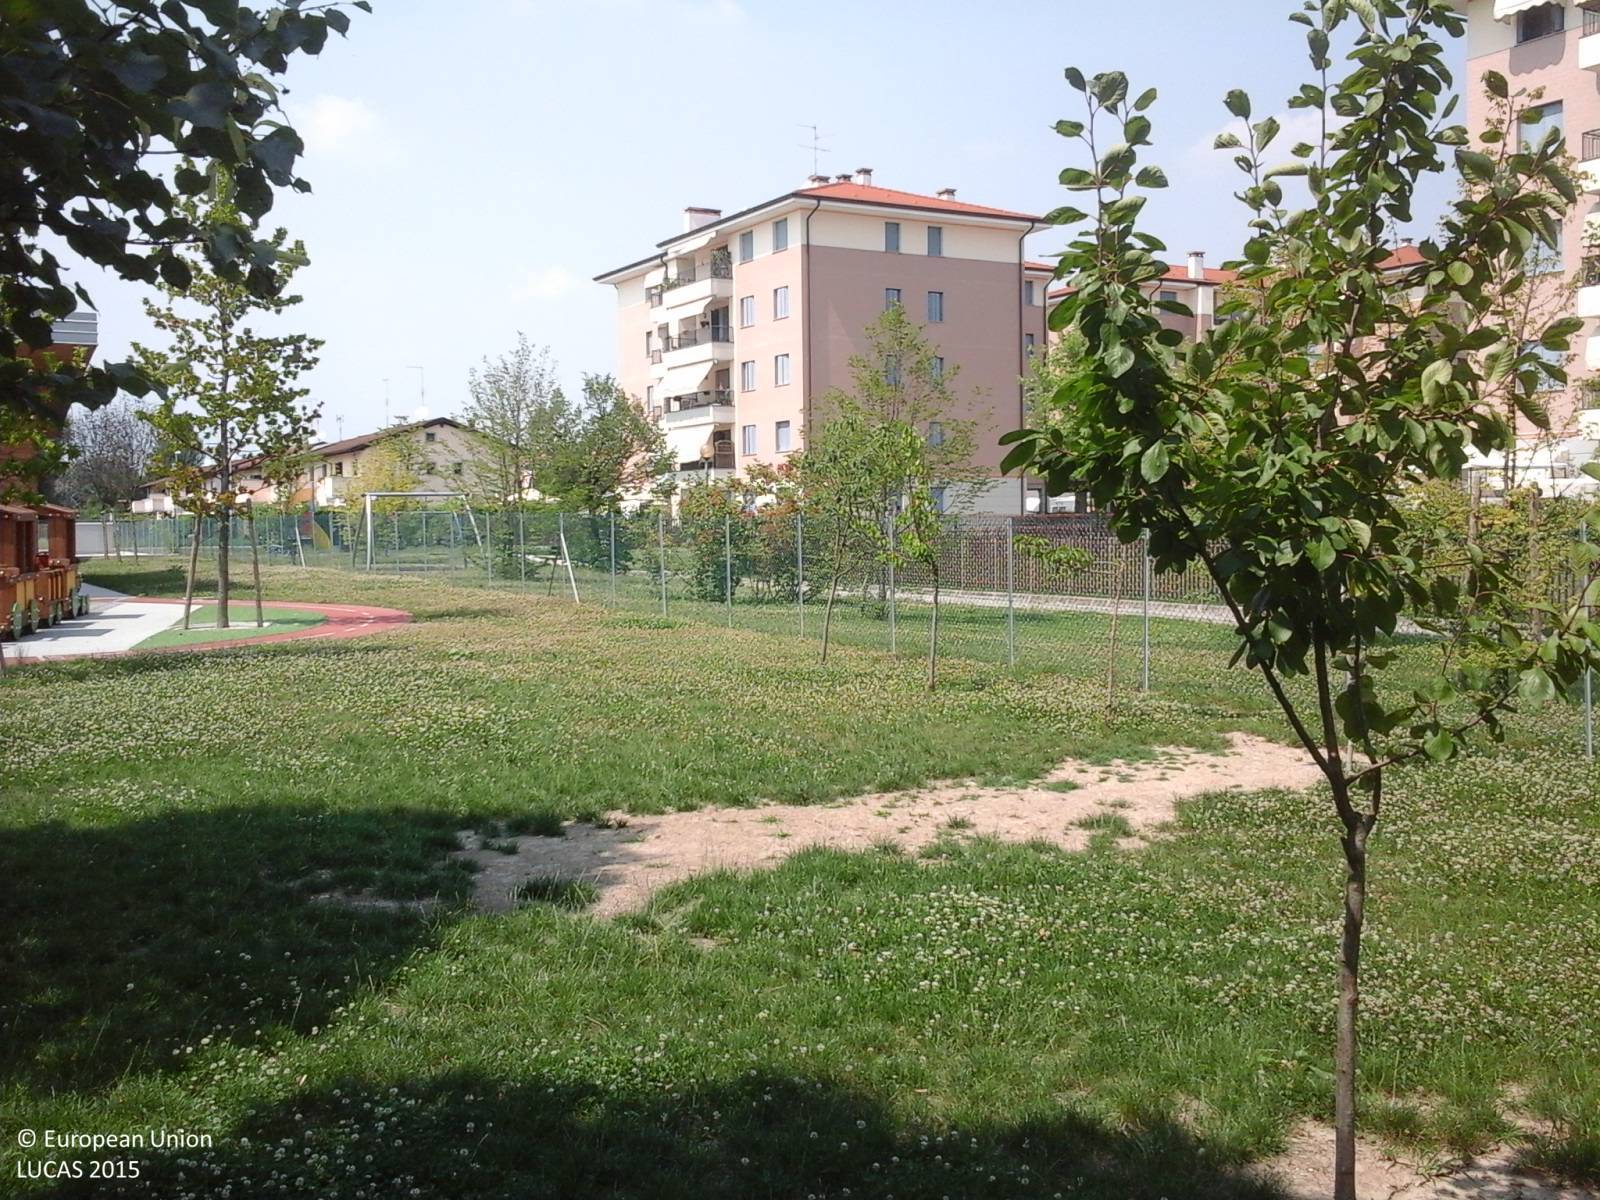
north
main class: Grassland
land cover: Grassland with sparse tree/shrub cover
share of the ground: > 75 %
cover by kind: herbaceous plants 95 %, broadleaved forest trees 5 %
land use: Community services
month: July
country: IT
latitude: 45.9395
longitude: 12.6666
